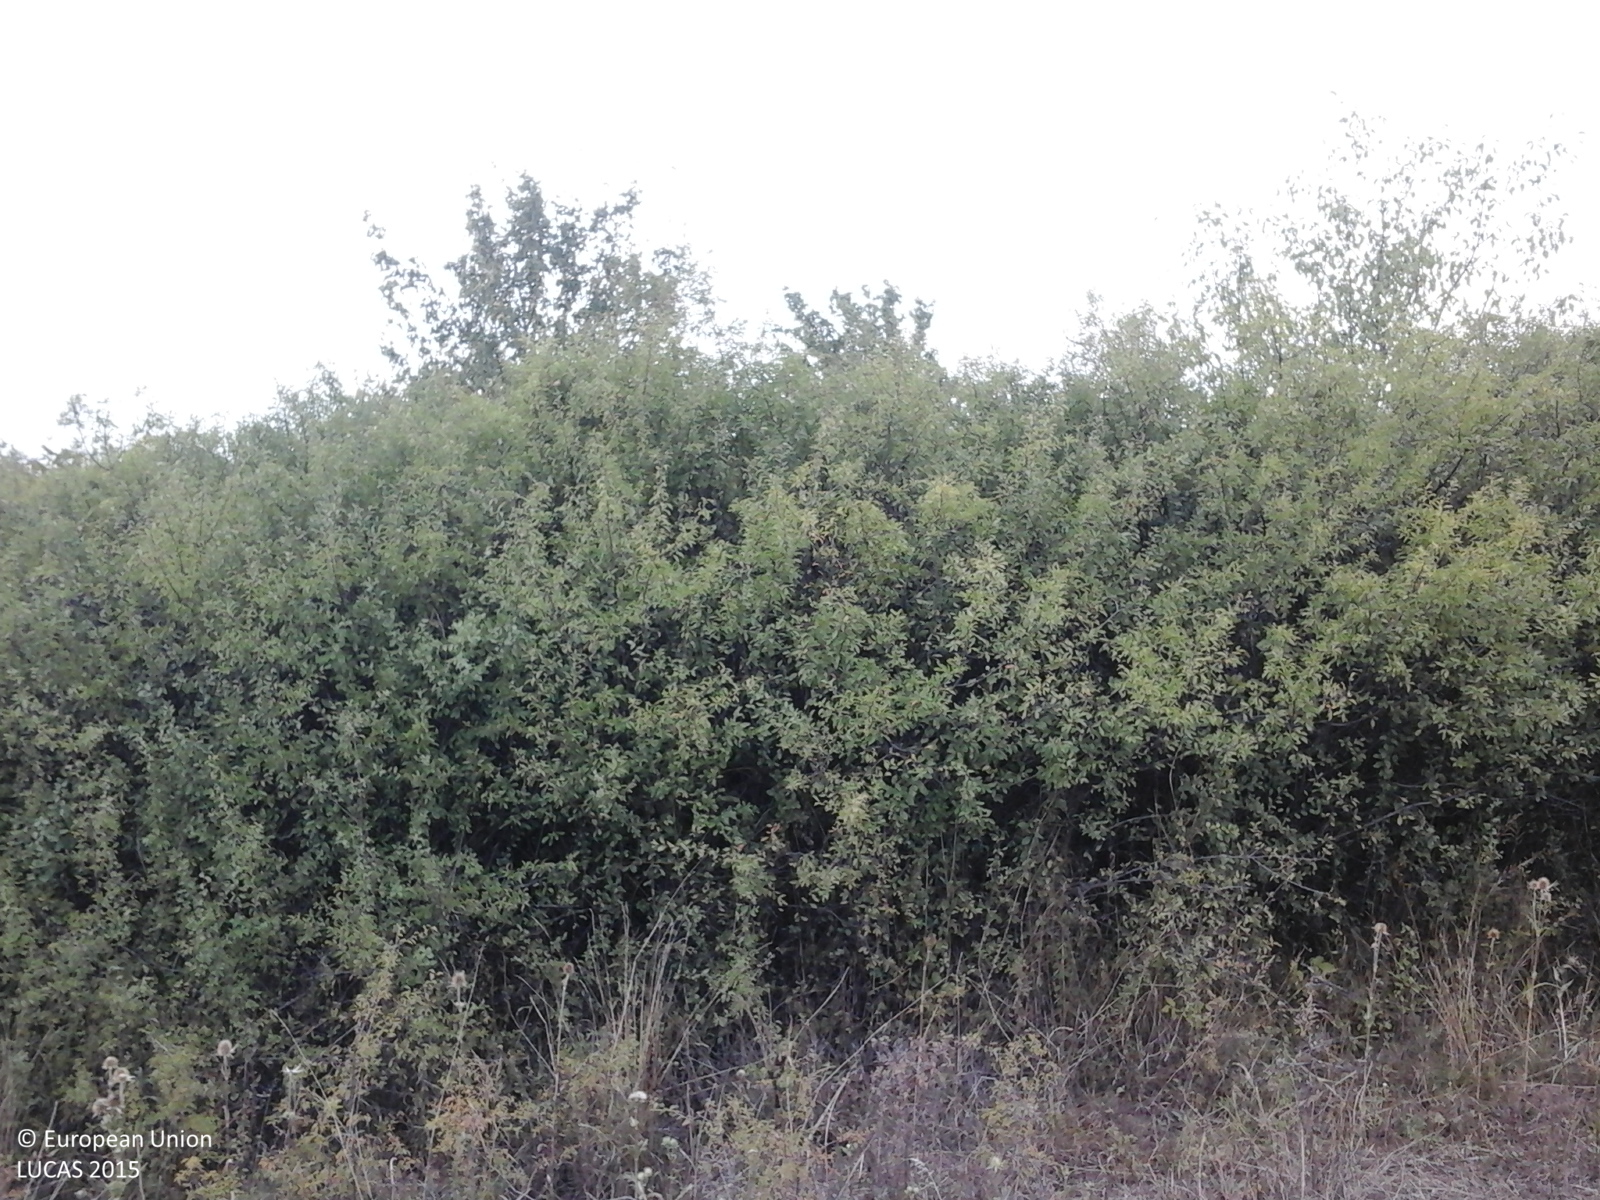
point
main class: Shrubland
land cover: Shrubland with sparse tree cover
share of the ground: > 75 %
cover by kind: herbaceous plants 80 %, shrubs 15 %, broadleaved forest trees 5 %
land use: Semi-natural and natural areas not in use
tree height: < 5 m
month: August
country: RO
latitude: 46.0421
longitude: 21.6282
